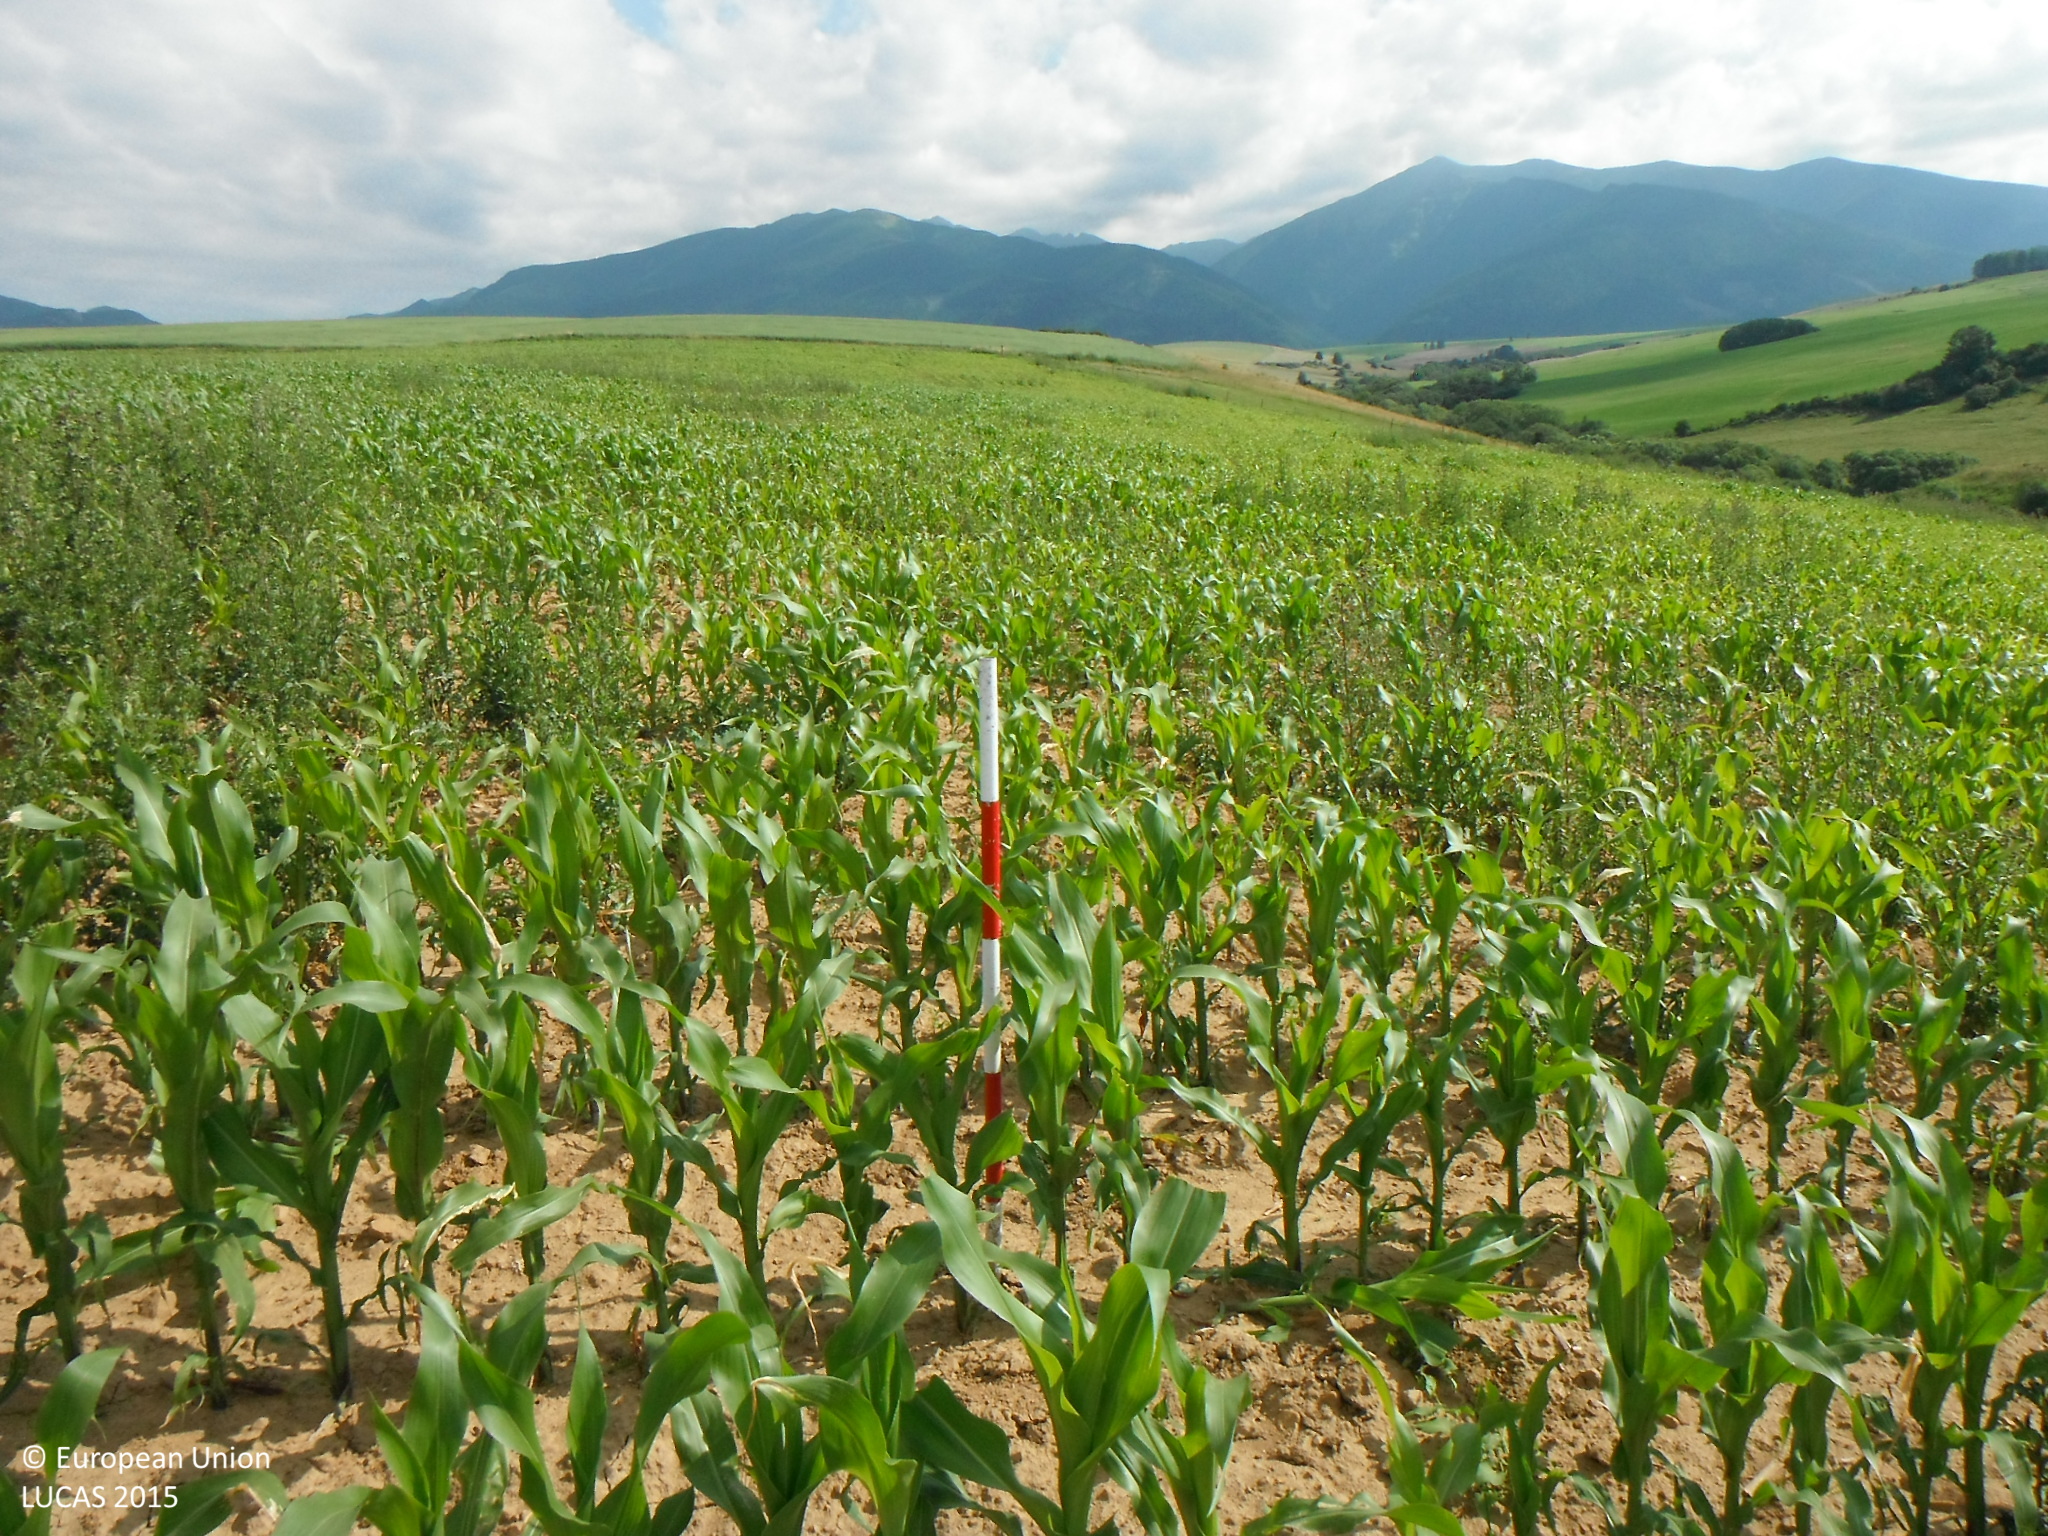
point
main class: Cropland
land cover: Maize
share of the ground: 50 - 75 %
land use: Agriculture (excluding fallow land and kitchen gardens)
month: July
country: SK
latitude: 49.1032
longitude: 19.6567
